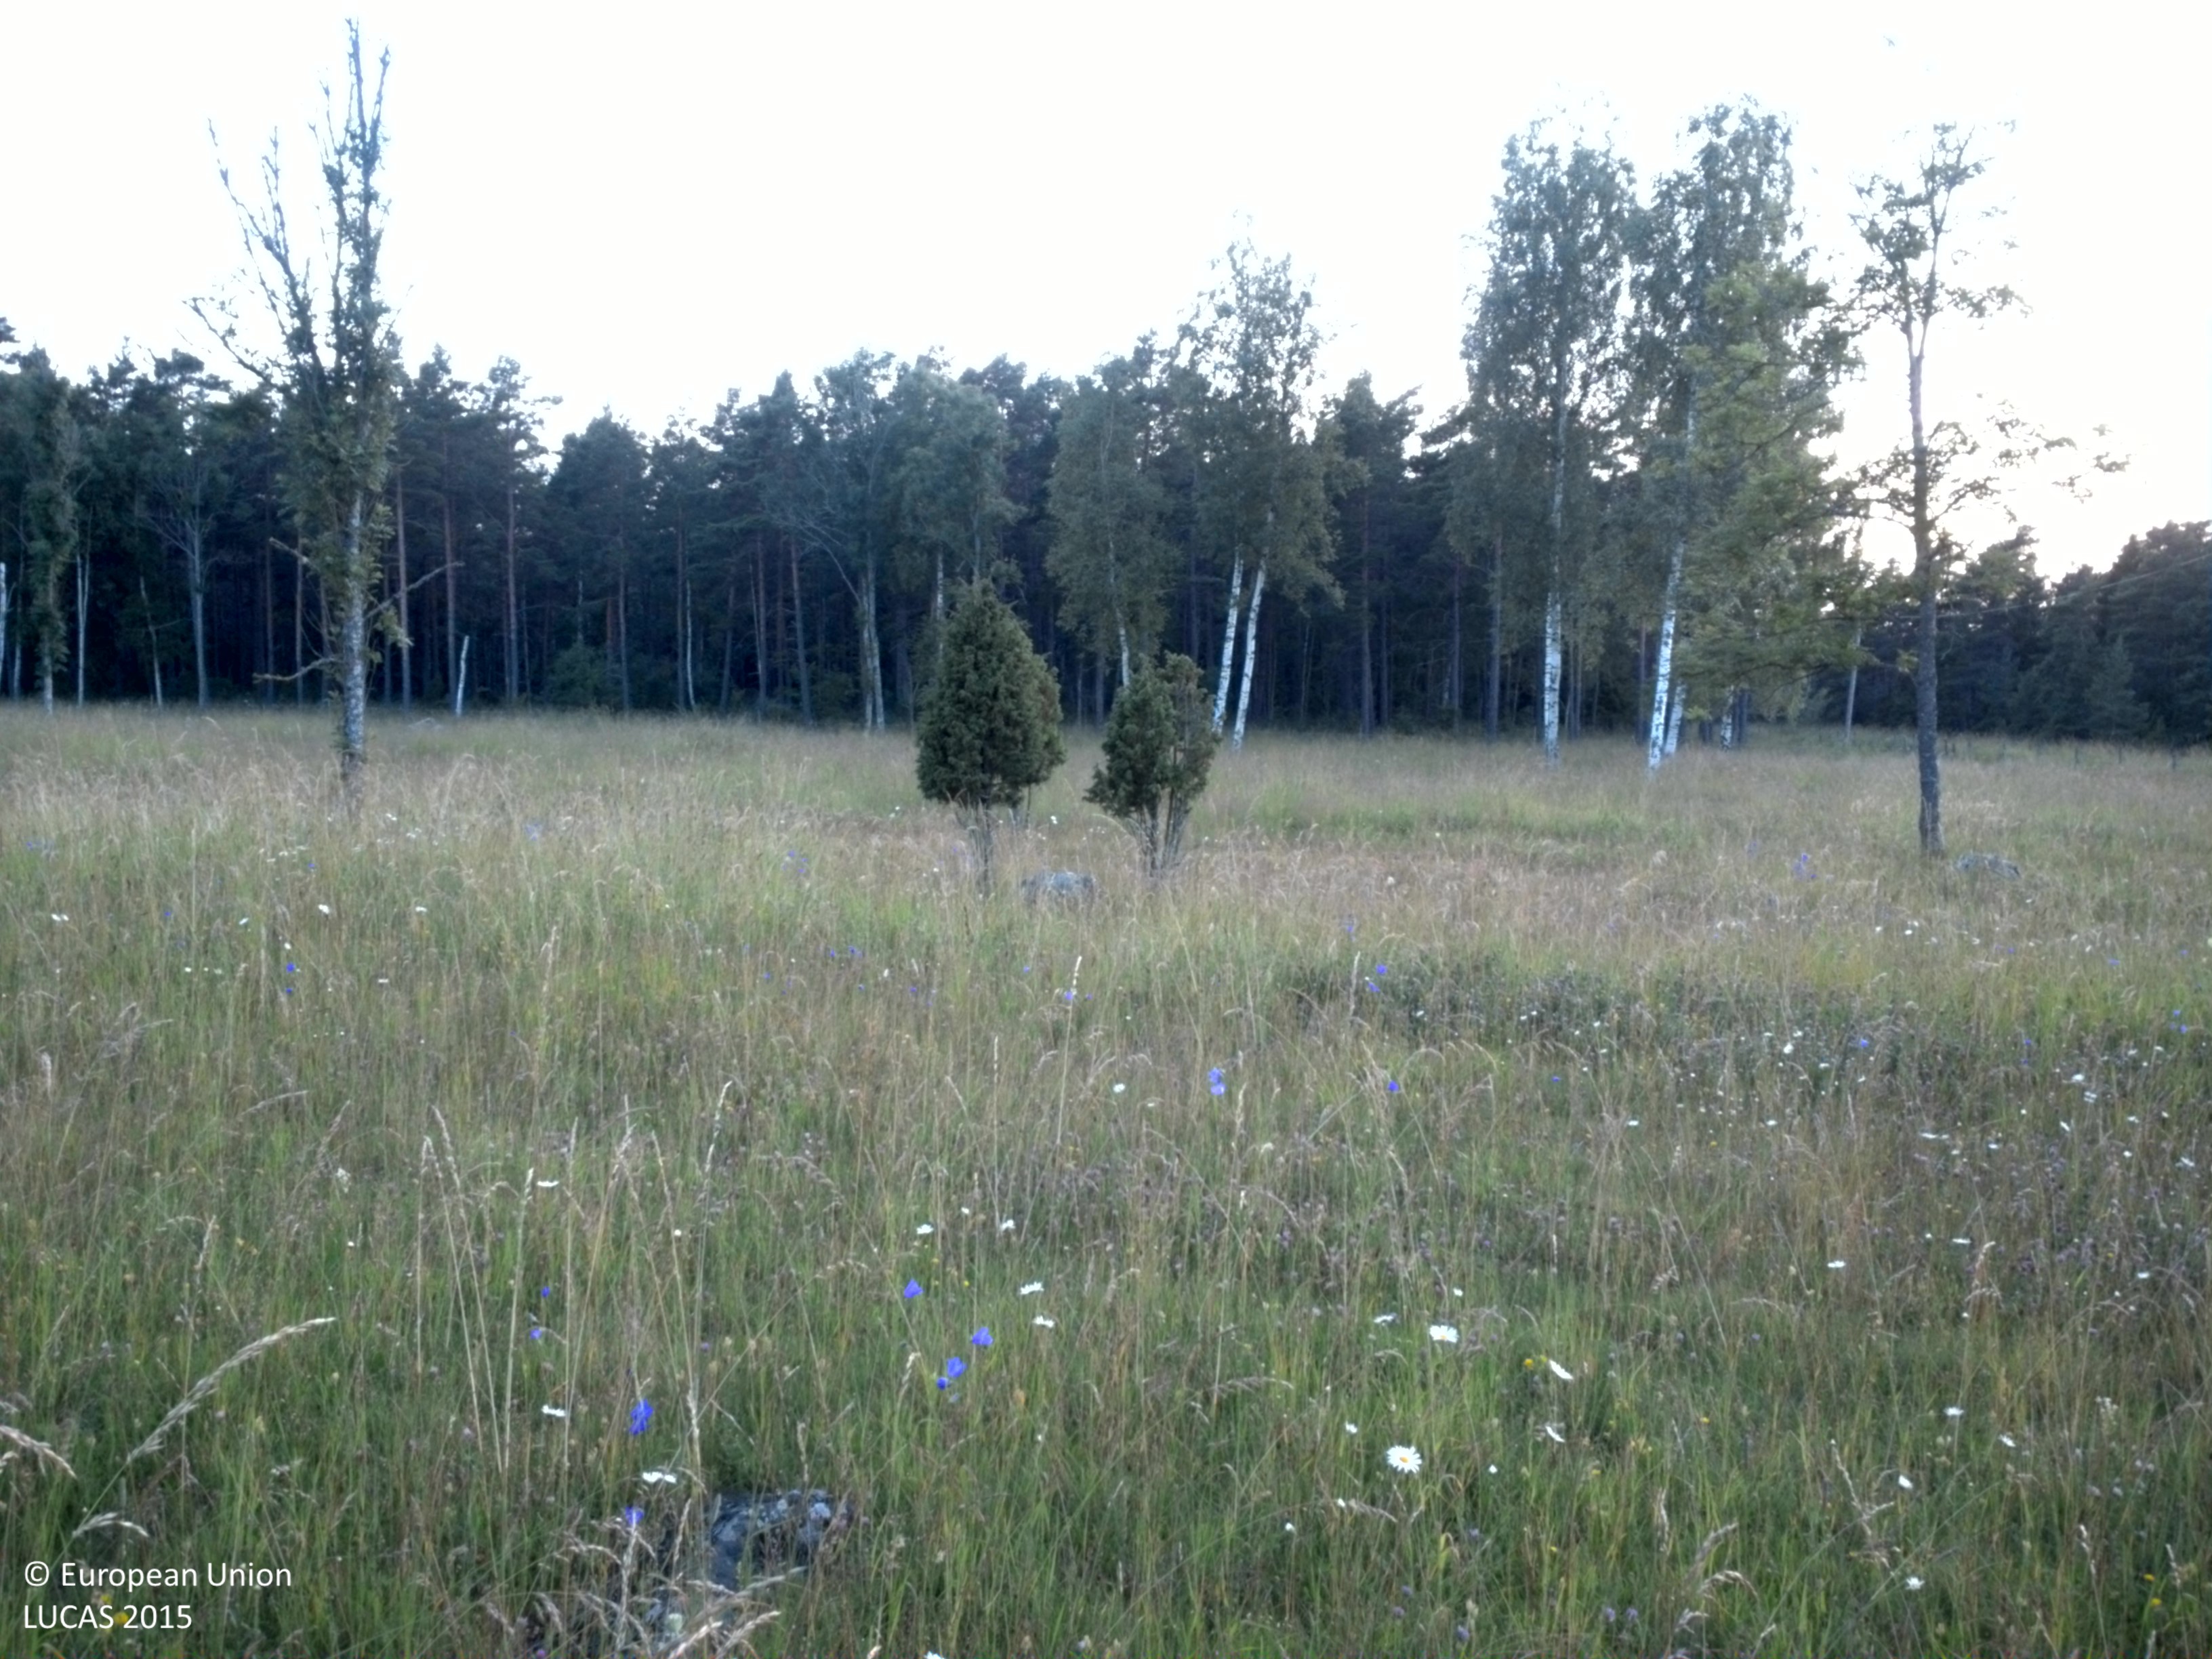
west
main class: Grassland
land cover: Grassland with sparse tree/shrub cover
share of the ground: > 75 %
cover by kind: herbaceous plants 95 %, broadleaved forest trees 5 %
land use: Agriculture (excluding fallow land and kitchen gardens)
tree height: > 5 m
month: July
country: SE
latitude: 57.6471
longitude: 18.7052
